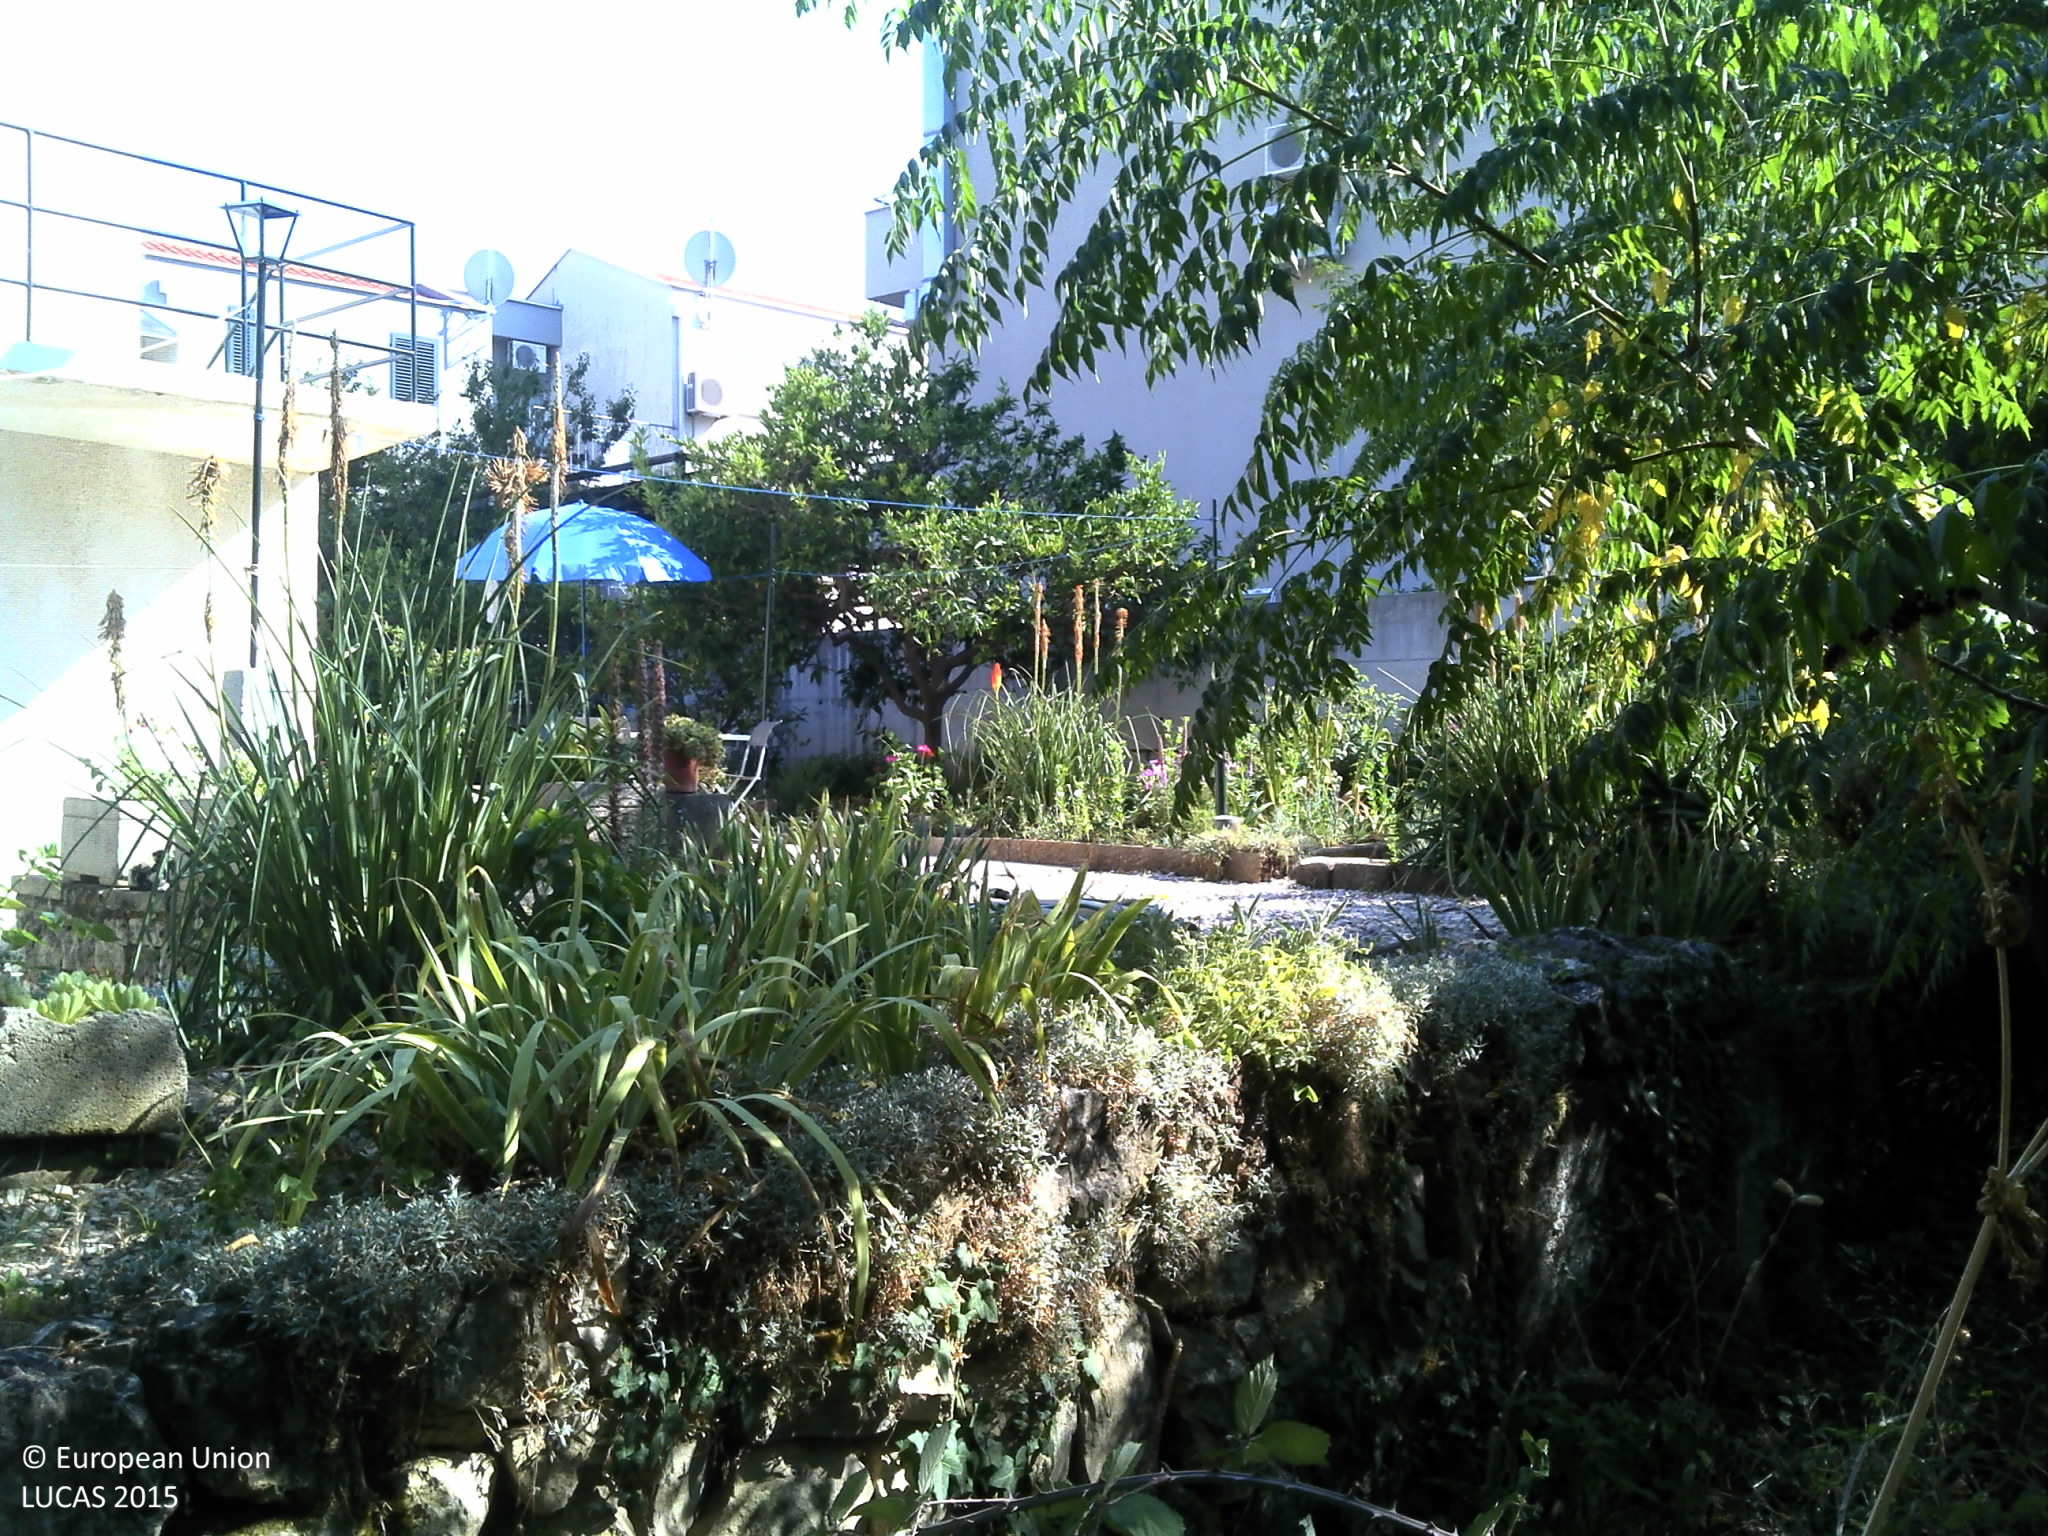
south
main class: Woodland
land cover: Broadleaved woodland
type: thermophilous deciduous forest
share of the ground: 50 - 75 %
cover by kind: broadleaved forest trees 55 %, herbaceous plants 15 %, coniferous forest trees 10 %, consolidated bare surface 10 %, lichens and mosses 5 %, unconsolidated bare surface 5 %
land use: Amenities, museums, leisure
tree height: > 5 m
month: July
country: HR
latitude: 42.6575
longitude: 18.0783
